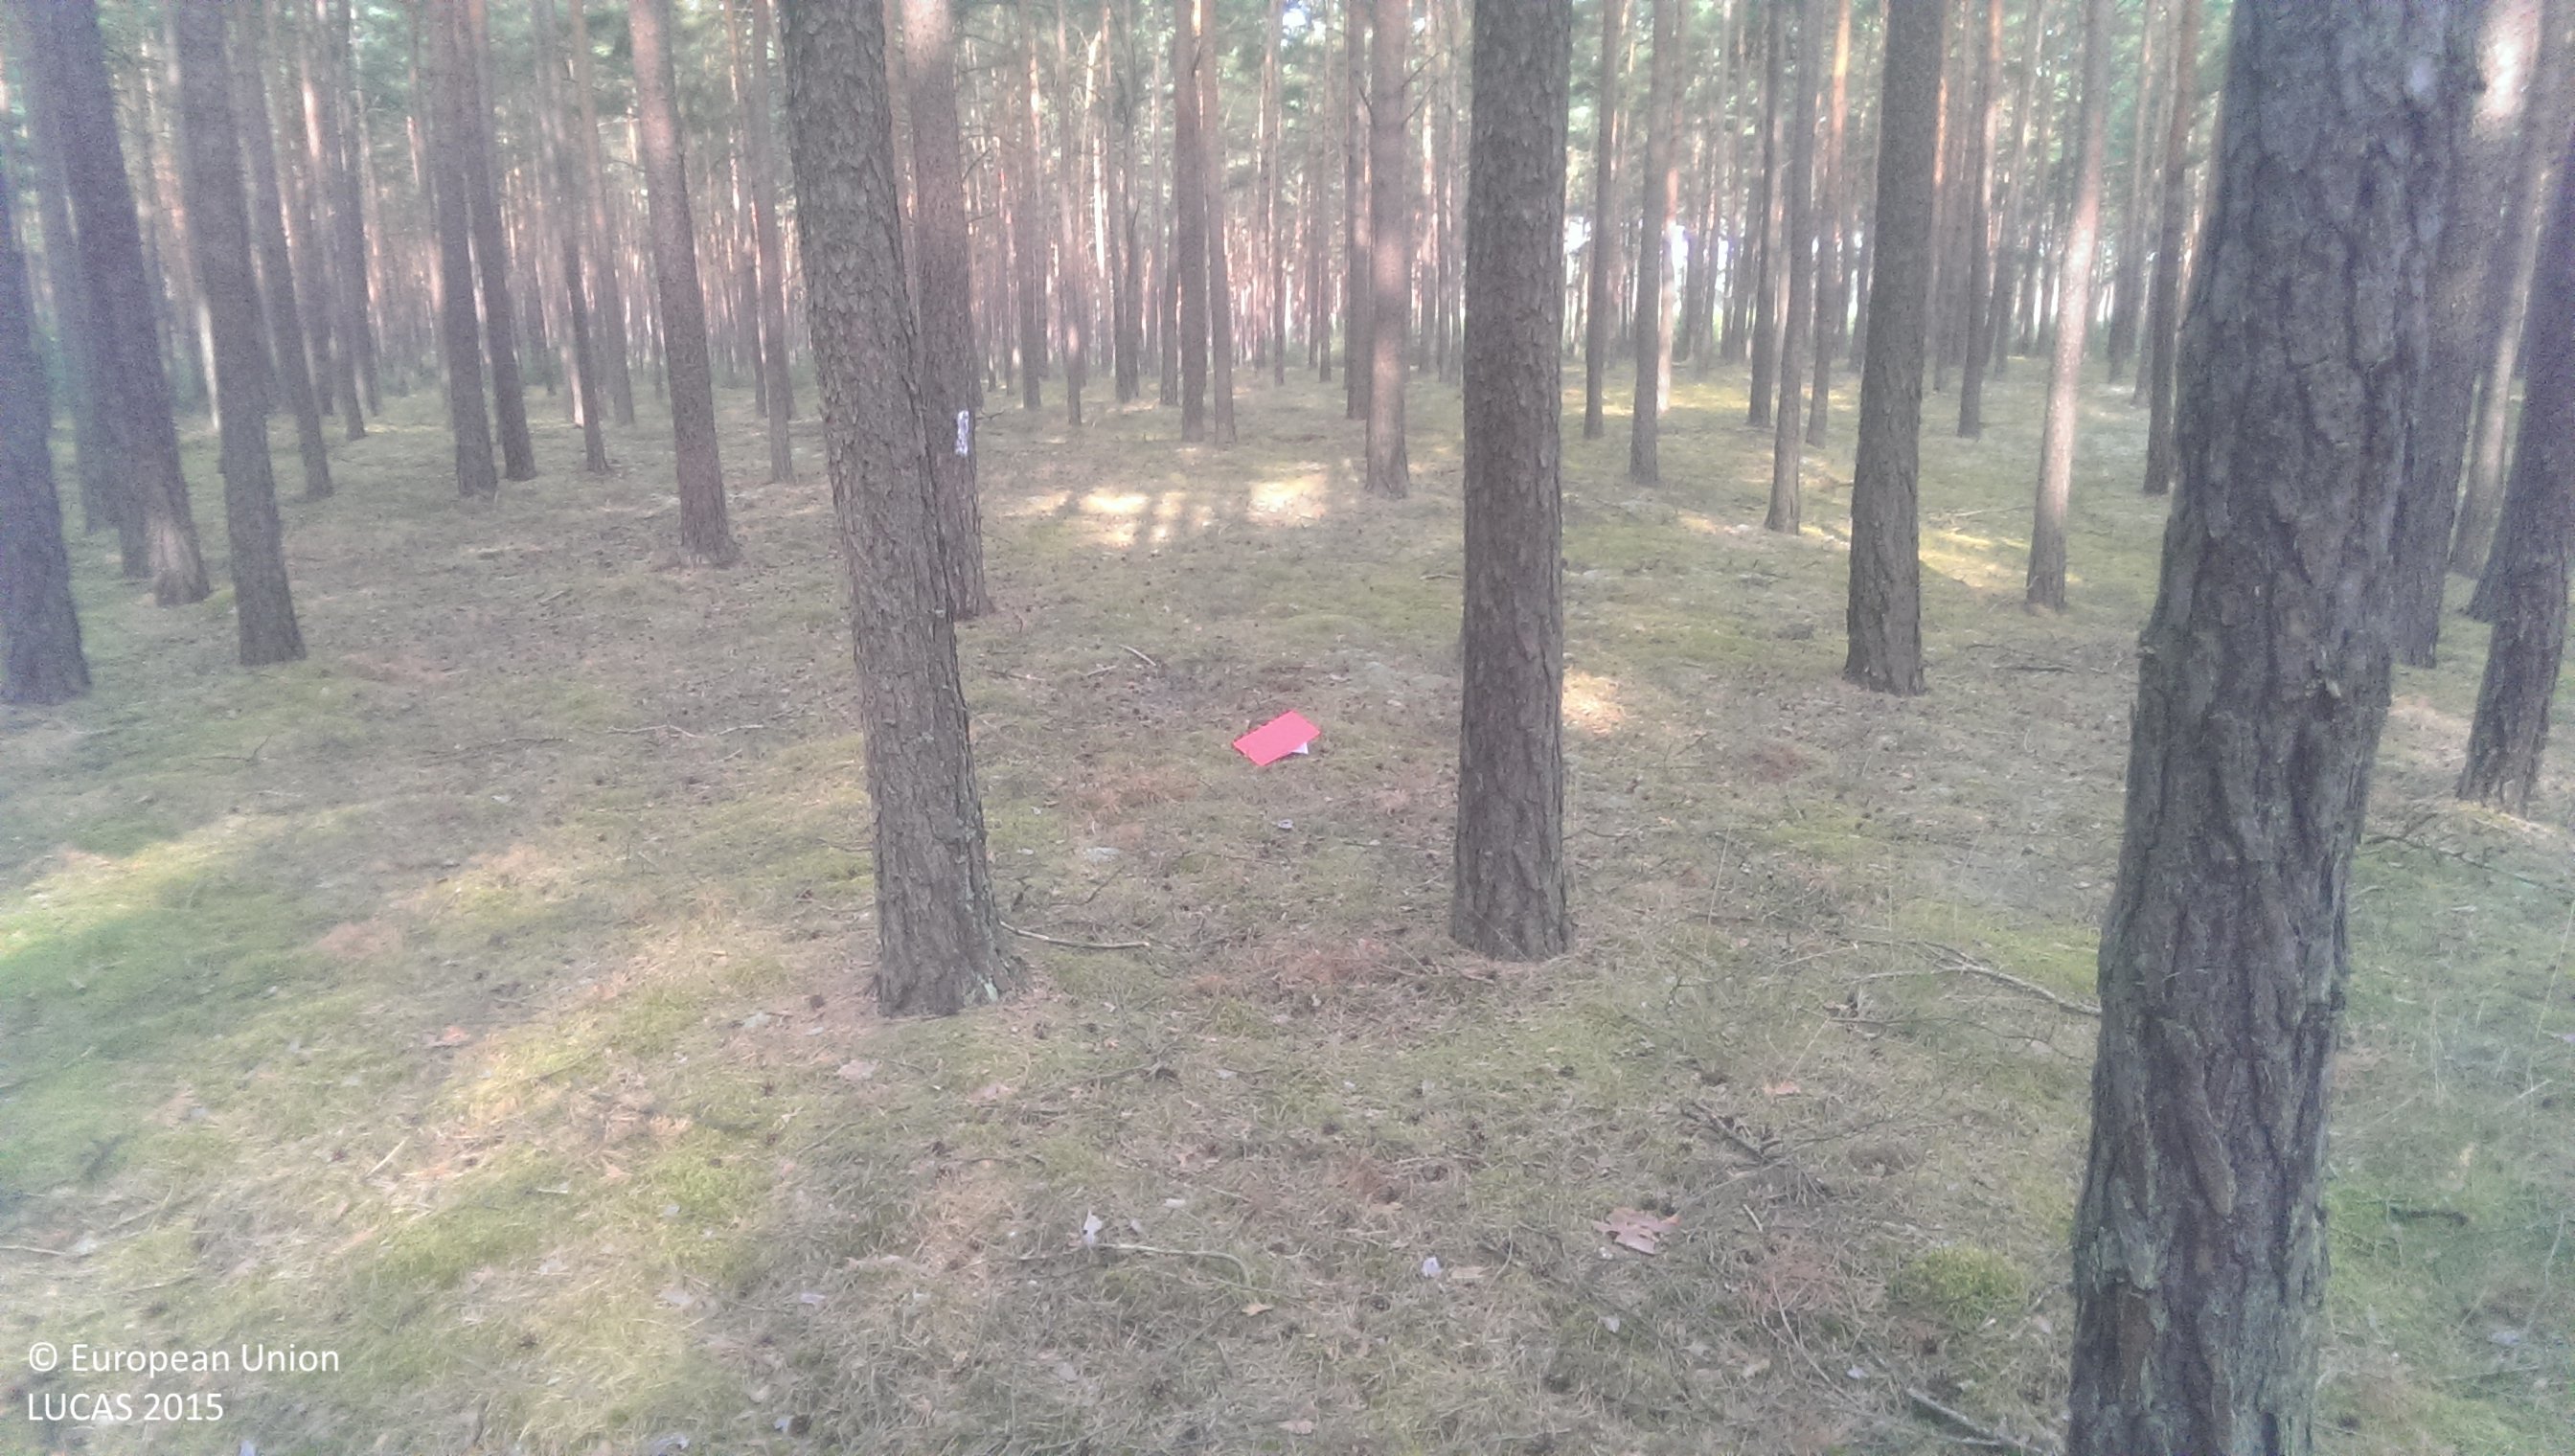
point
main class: Woodland
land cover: Pine dominated coniferous woodland
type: hemiboreal forest and nemoral coniferous forest and mixed broadleaved-coniferous forest
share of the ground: > 75 %
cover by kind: coniferous forest trees 80 %, lichens and mosses 20 %
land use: Forestry
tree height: > 5 m
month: July
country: PL
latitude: 52.4059
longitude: 15.6342
